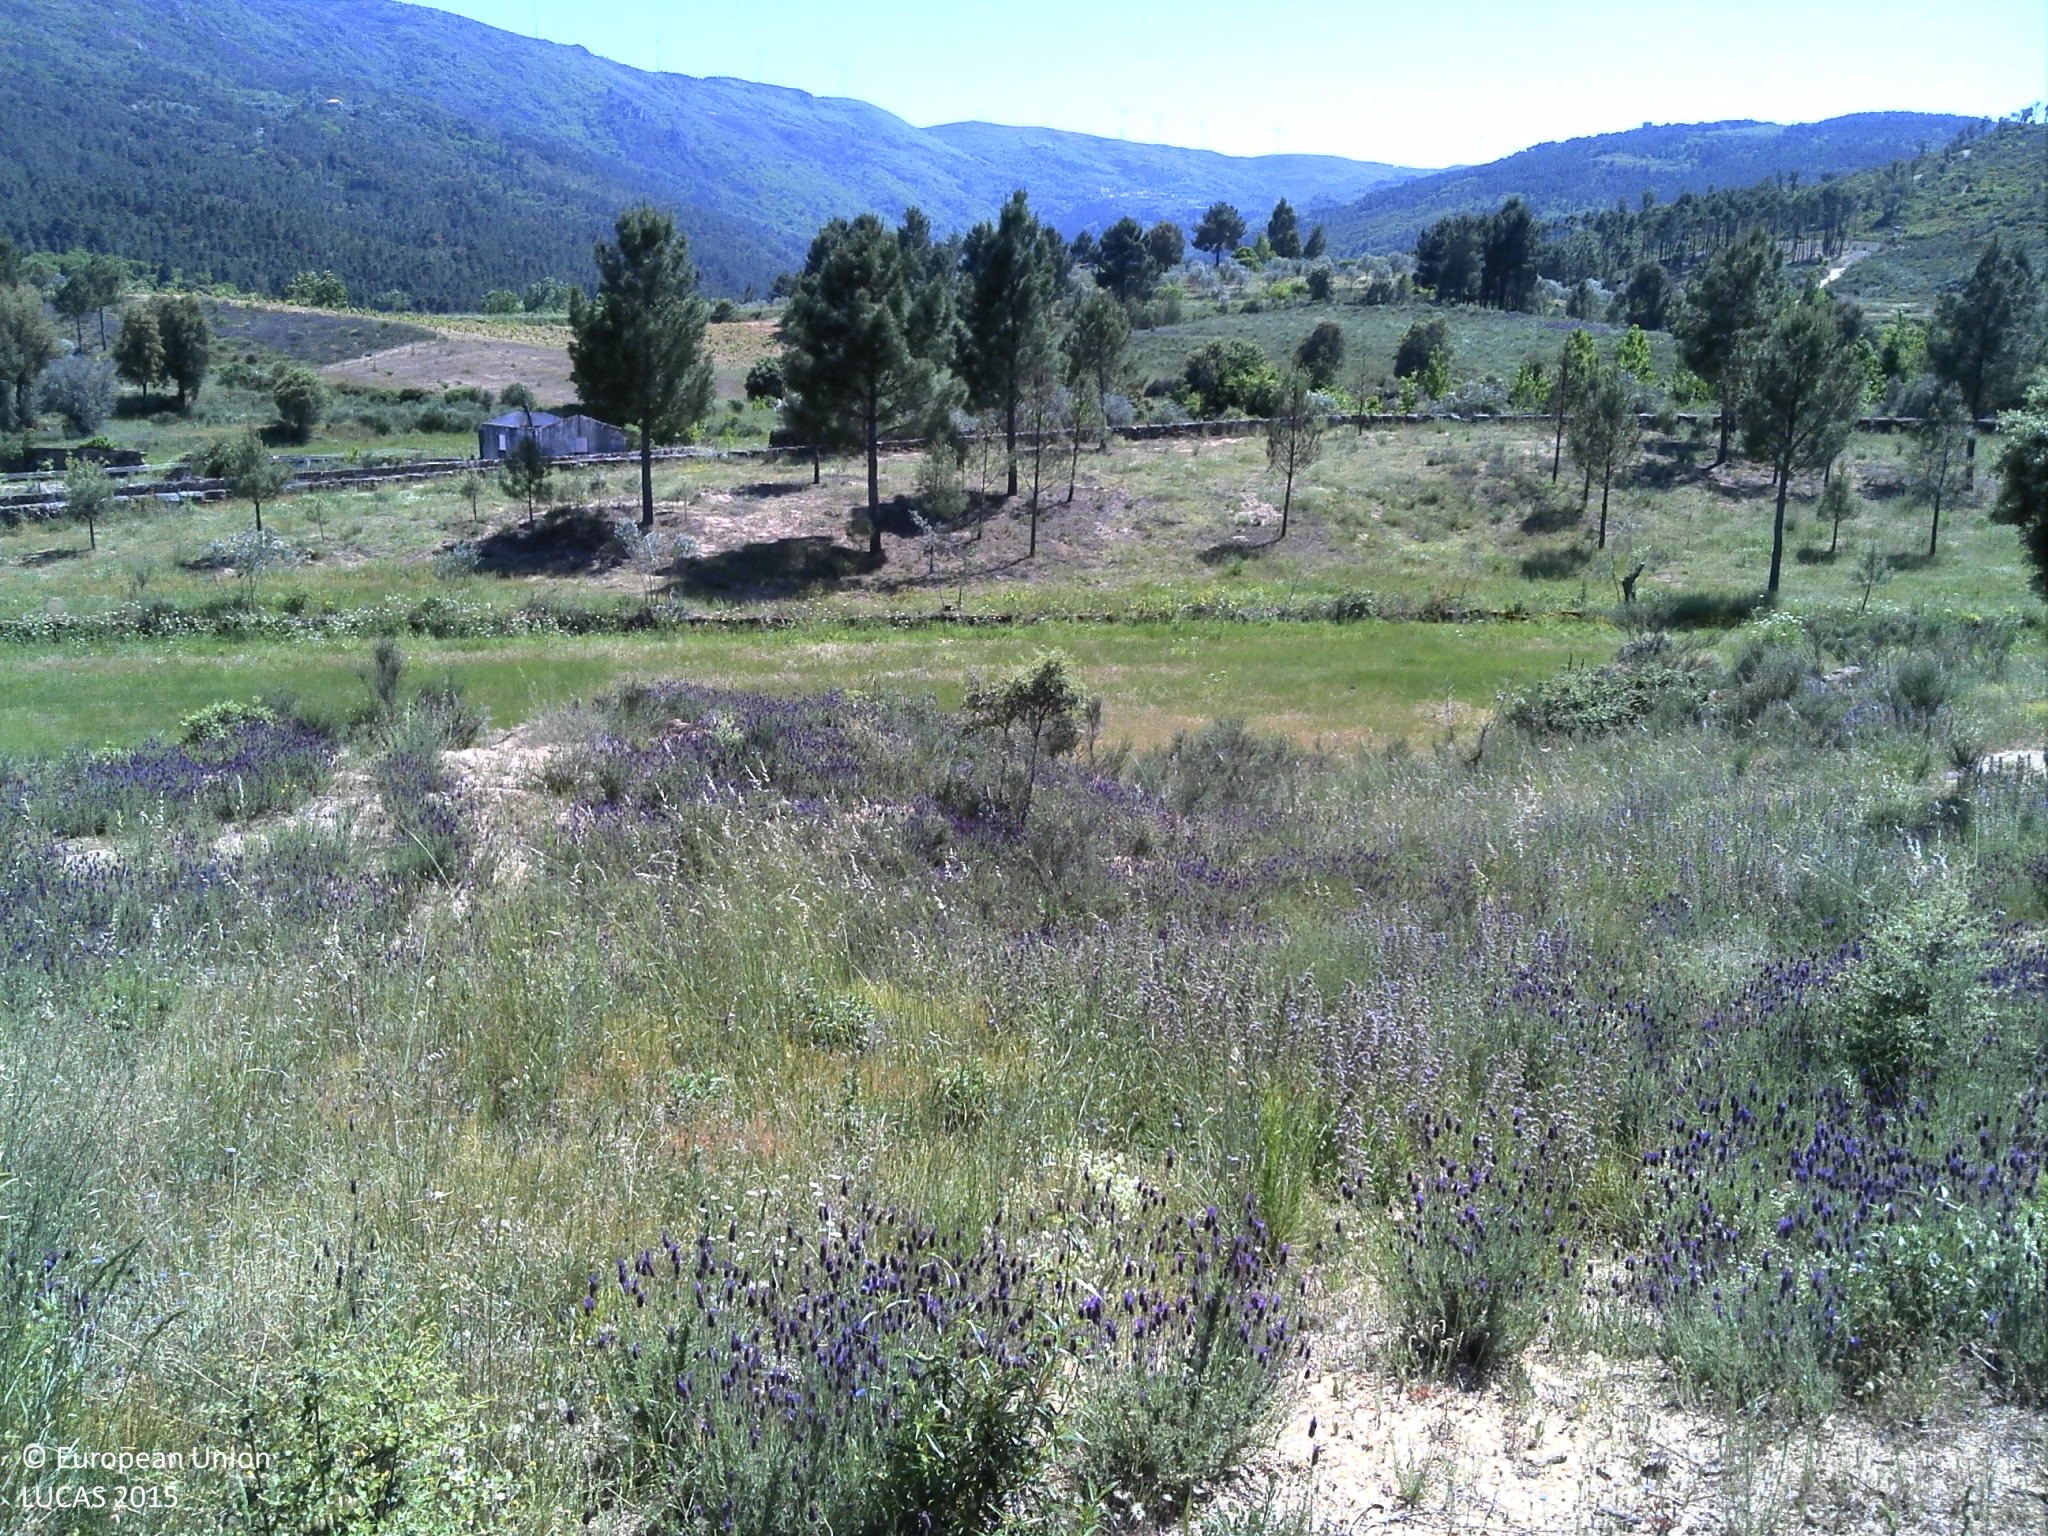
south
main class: Shrubland
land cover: Shrubland with sparse tree cover
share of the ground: 50 - 75 %
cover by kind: shrubs 65 %, unconsolidated bare surface 30 %, coniferous forest trees 5 %
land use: Forestry
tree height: > 5 m
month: May
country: PT
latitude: 41.6070
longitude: -7.5409
